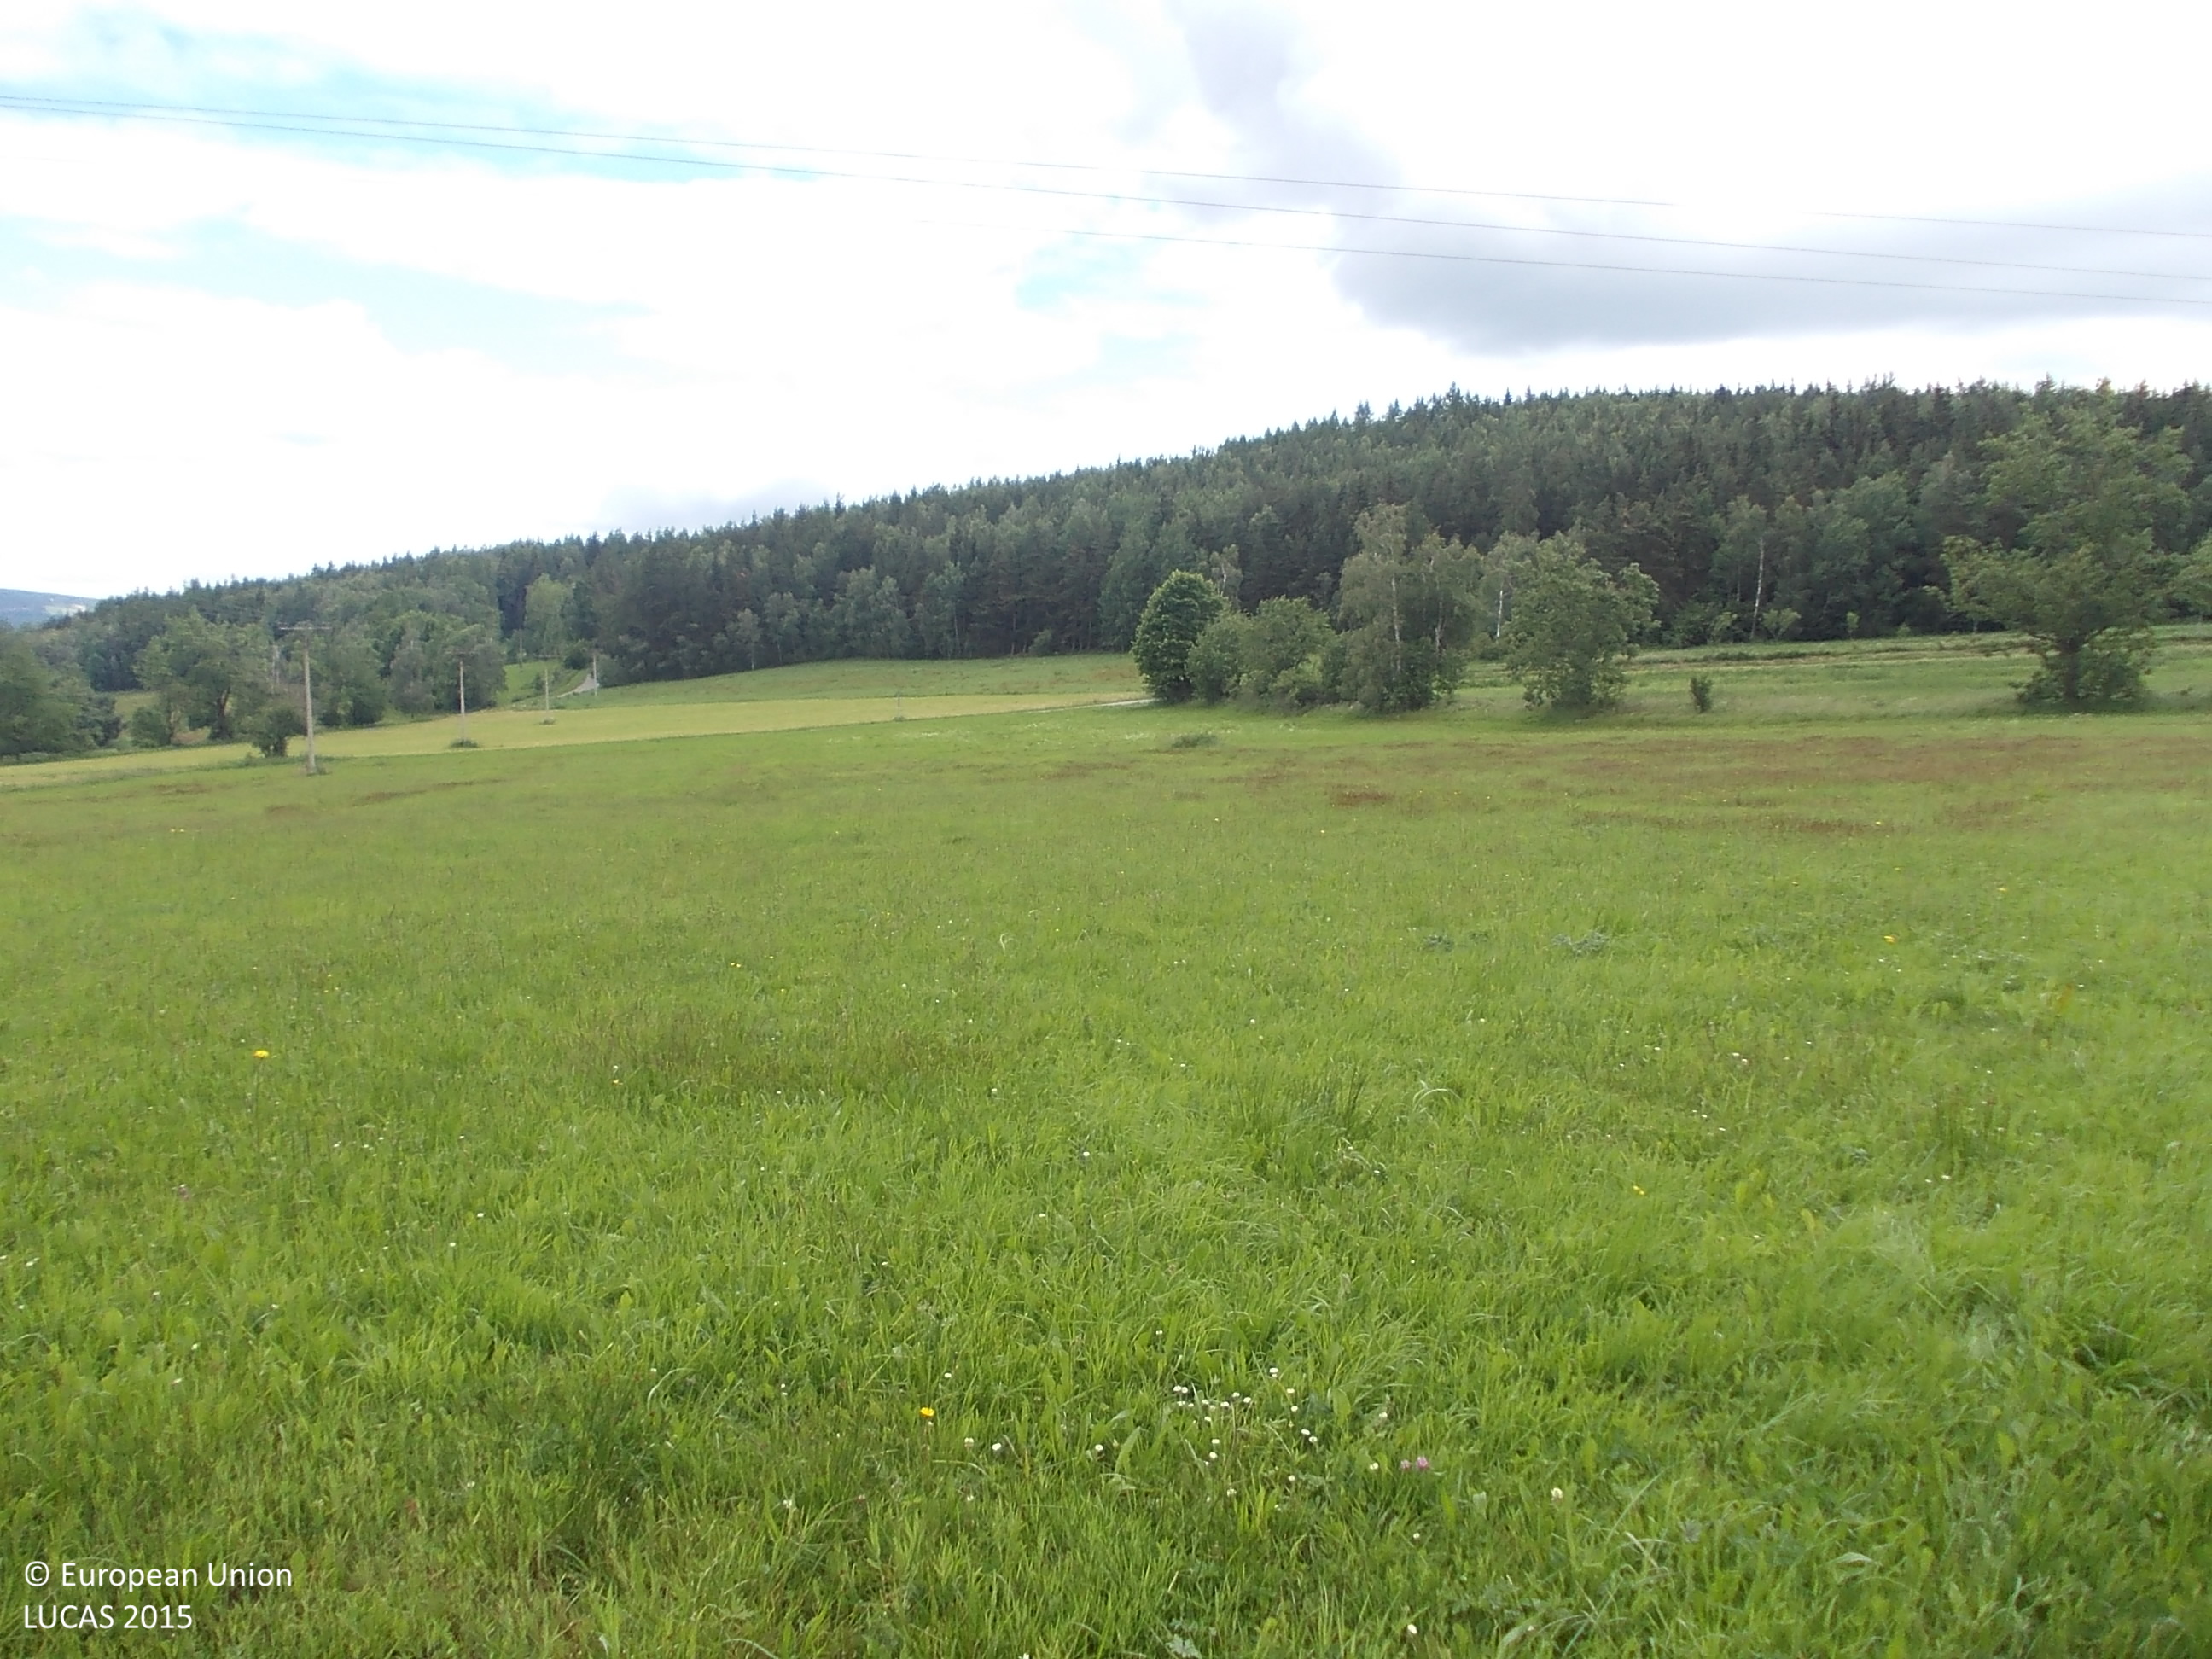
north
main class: Grassland
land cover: Grassland without tree/shrub cover
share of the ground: > 75 %
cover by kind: herbaceous plants 100 %
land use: Agriculture (excluding fallow land and kitchen gardens)
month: June
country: CZ
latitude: 49.0797
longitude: 13.7103
